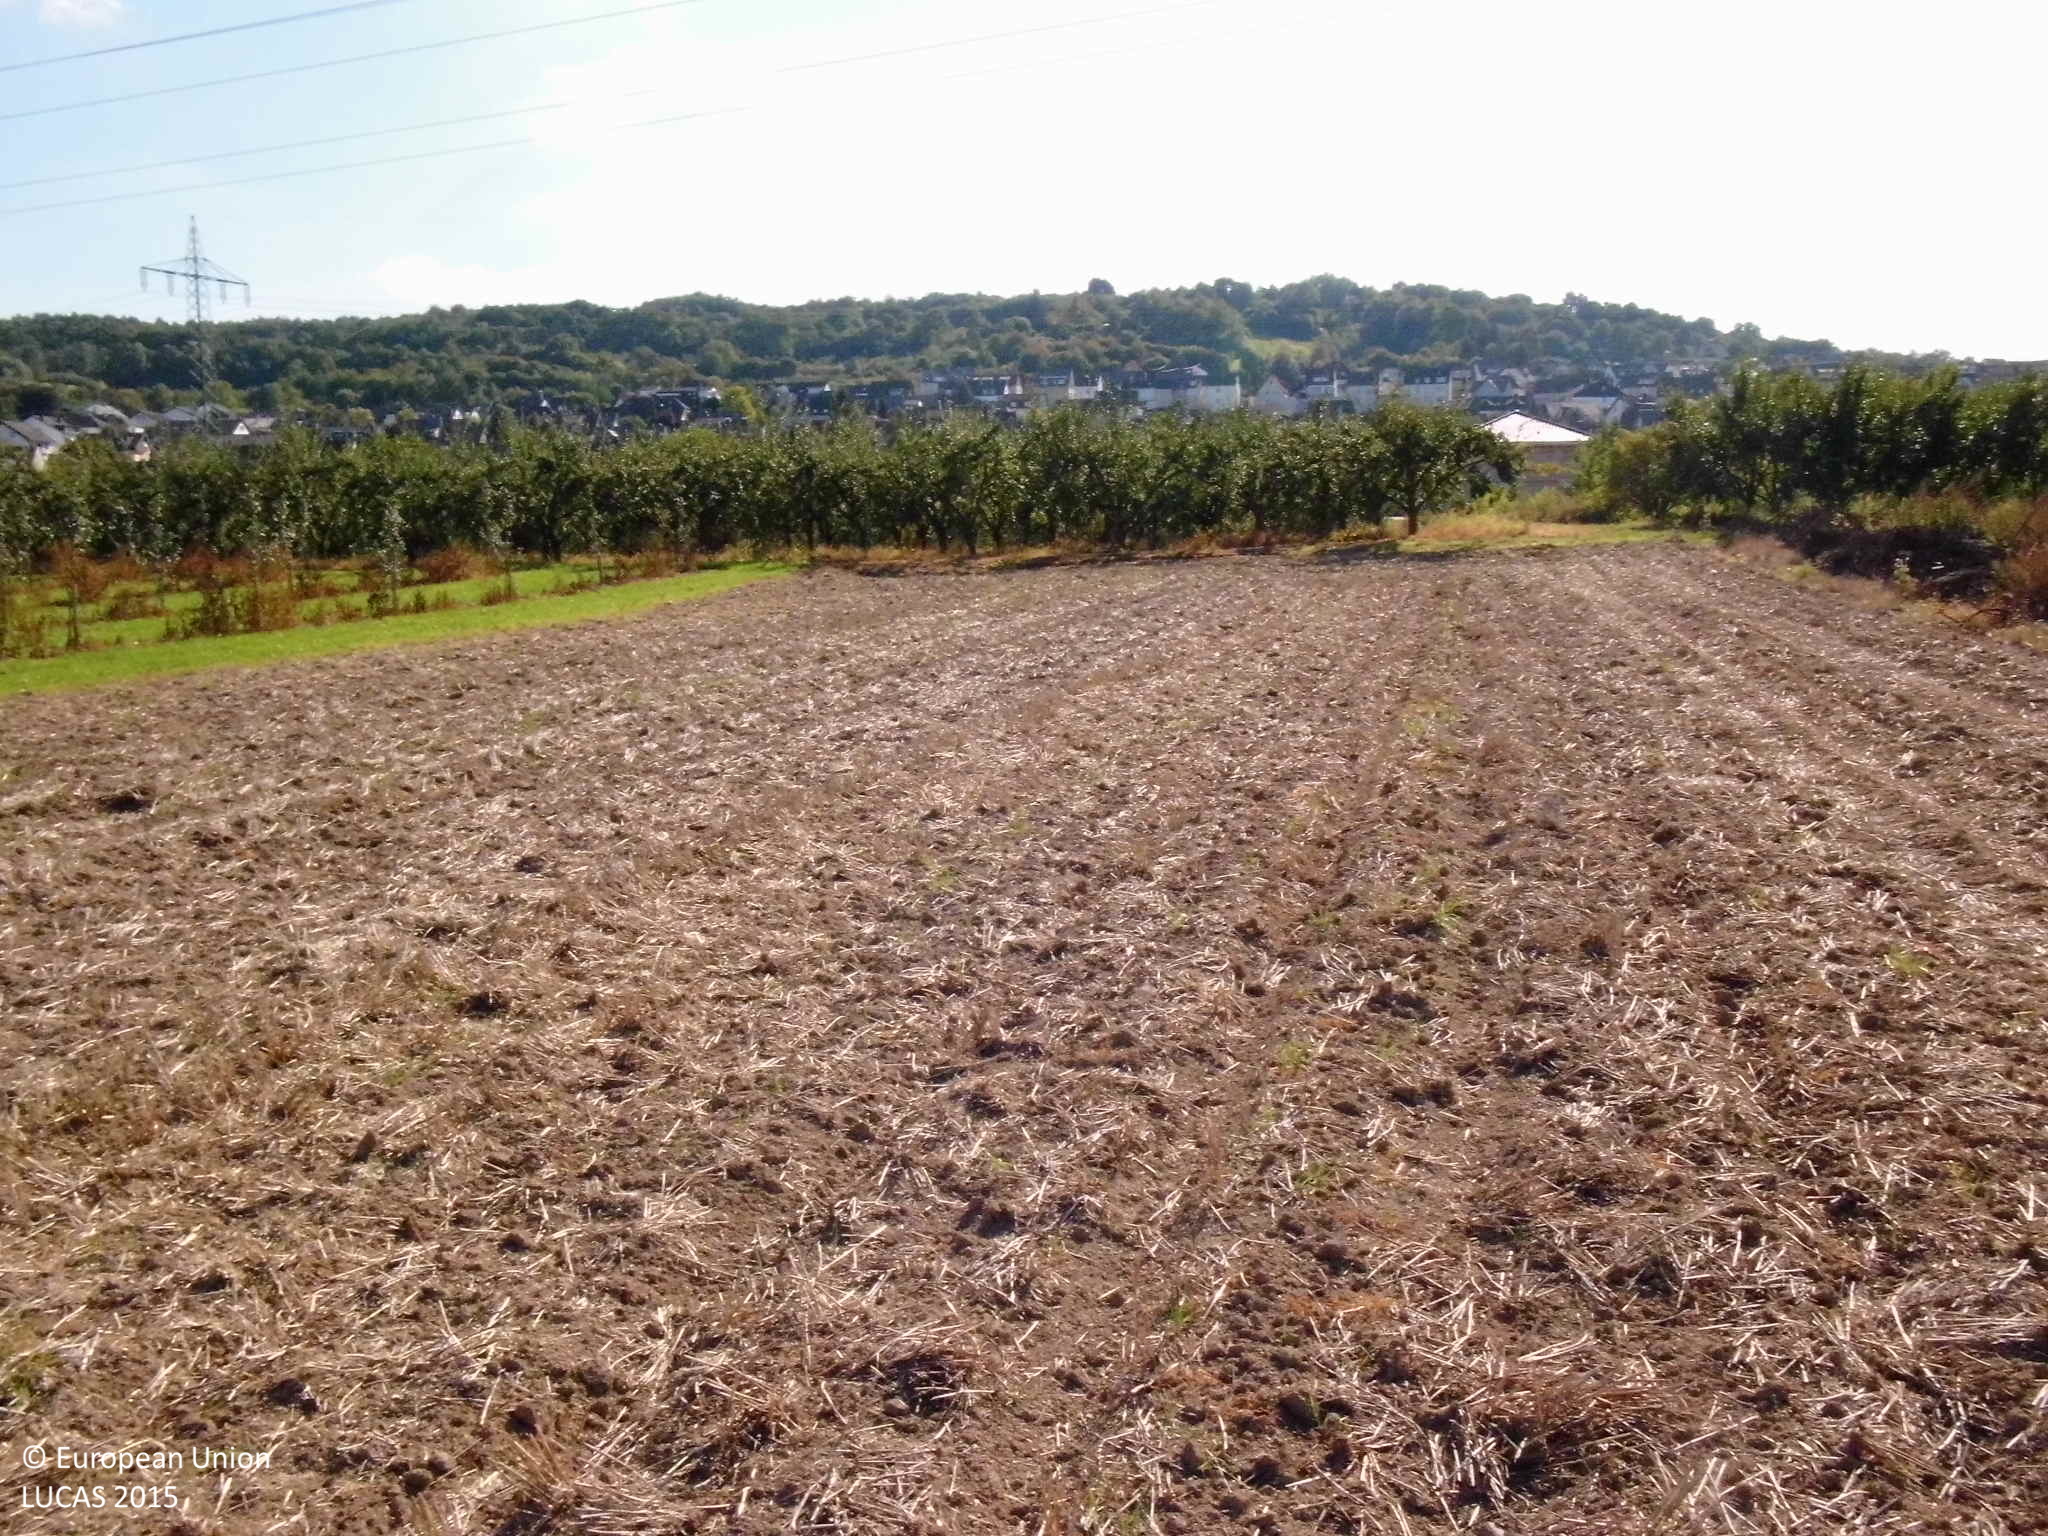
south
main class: Artificial land
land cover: Other artificial areas
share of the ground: < 10 %
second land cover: Common wheat
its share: < 10 %
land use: Electricity, gas and thermal power distribution
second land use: Agriculture (excluding fallow land and kitchen gardens)
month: September
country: DE
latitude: 50.3910
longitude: 7.5106
